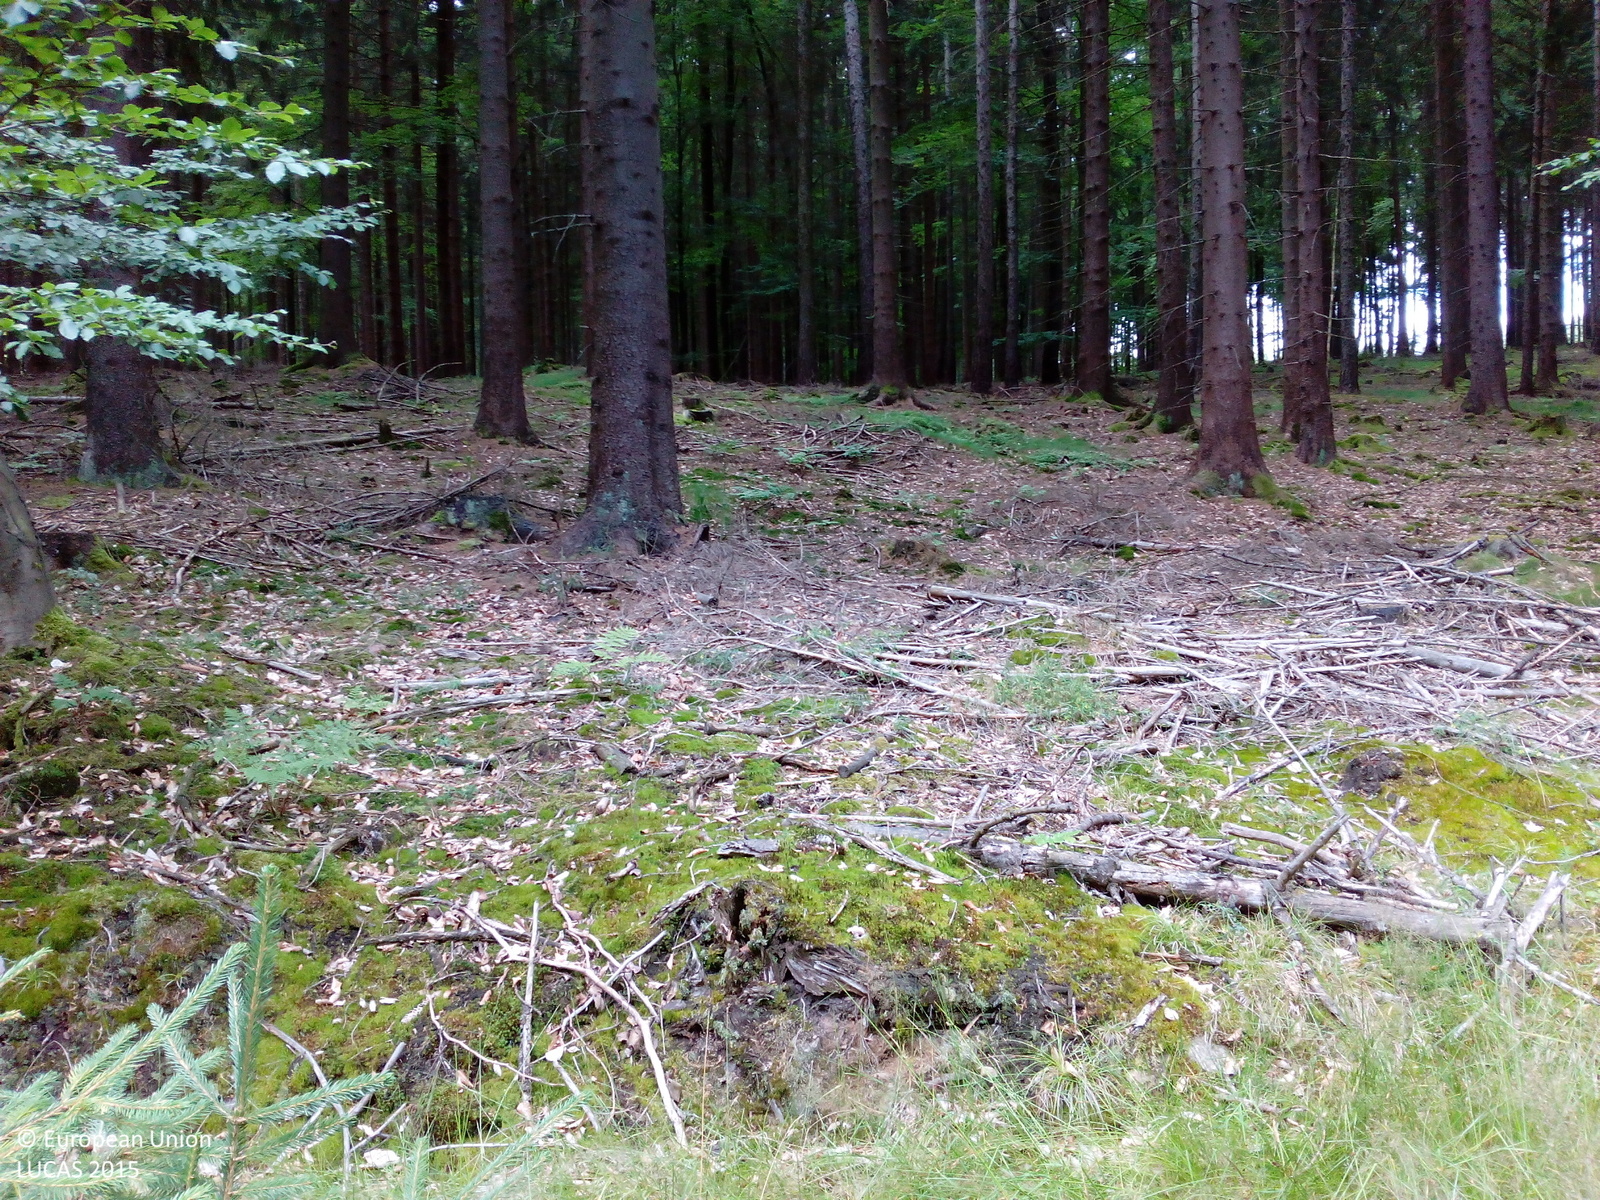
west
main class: Woodland
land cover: Spruce dominated mixed woodland
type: hemiboreal forest and nemoral coniferous forest and mixed broadleaved-coniferous forest
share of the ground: > 75 %
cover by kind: coniferous forest trees 50 %, broadleaved forest trees 25 %, herbaceous plants 15 %, shrubs 10 %
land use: Forestry
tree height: < 5 m
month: July
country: DE
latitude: 49.7817
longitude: 12.3745
